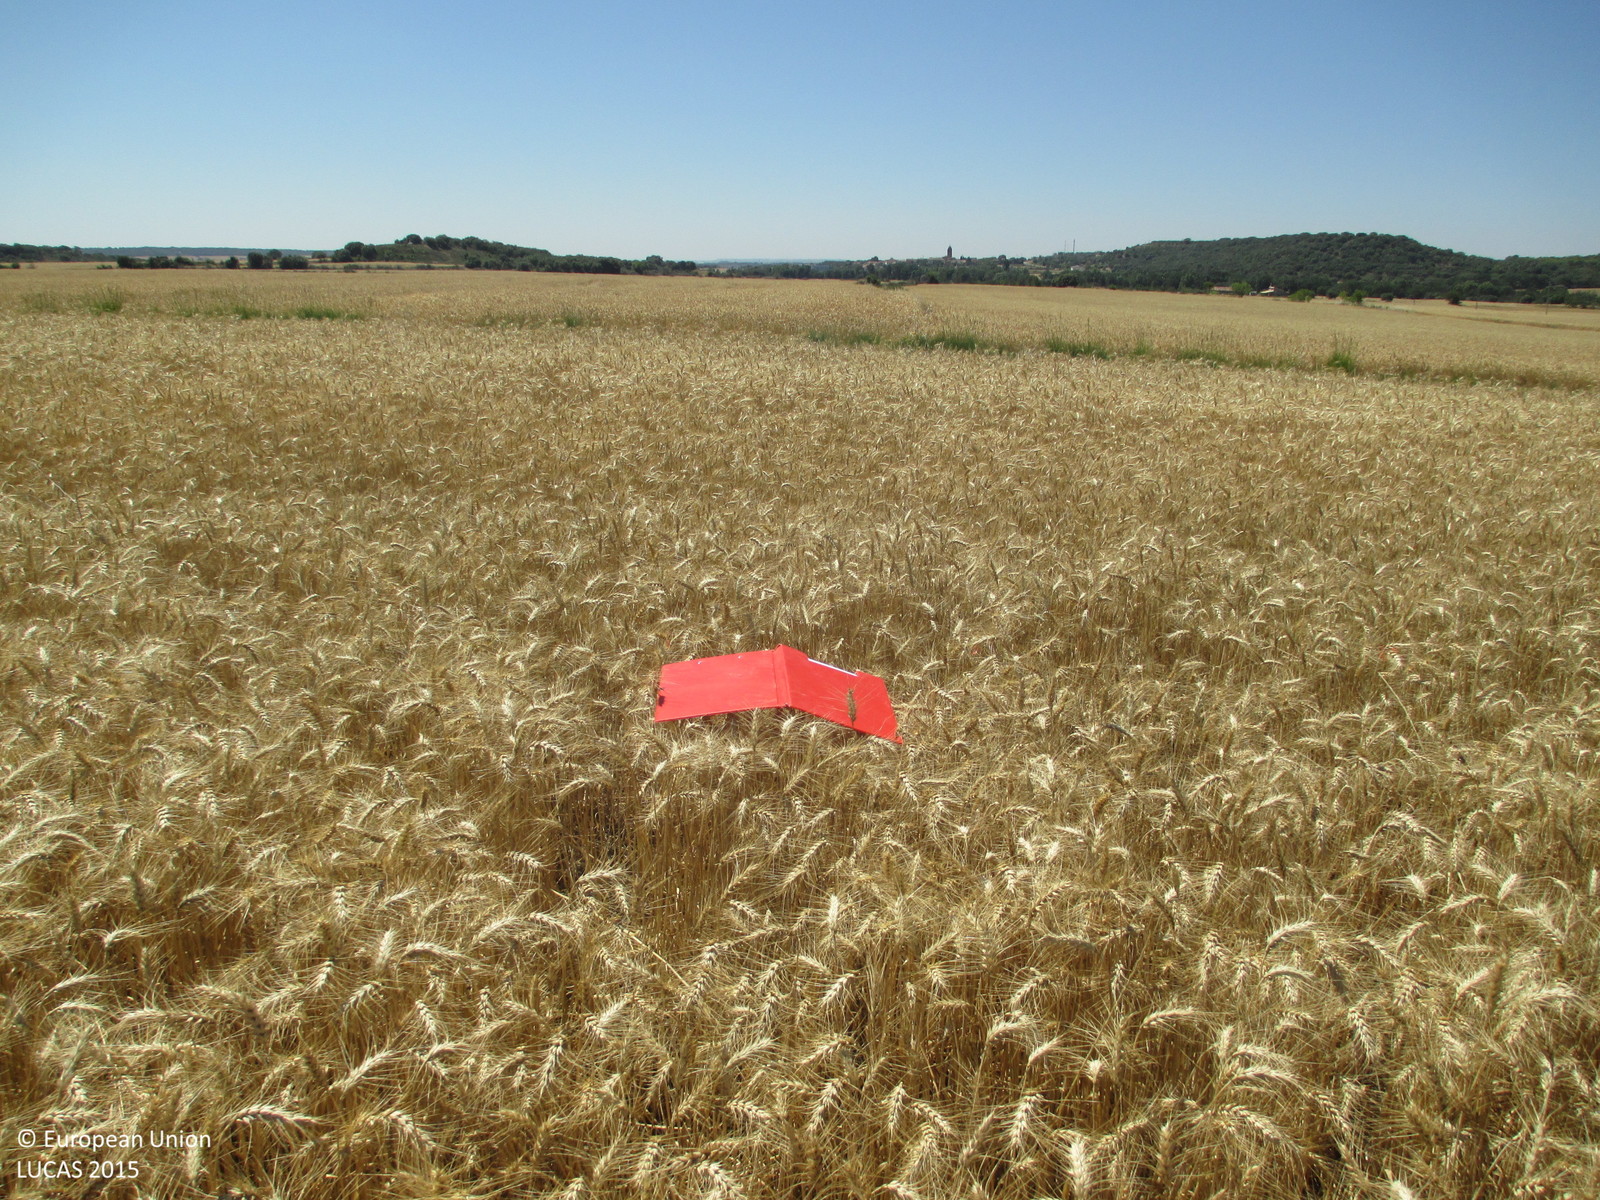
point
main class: Cropland
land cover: Durum wheat
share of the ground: > 75 %
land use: Agriculture (excluding fallow land and kitchen gardens)
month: June
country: ES
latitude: 42.1795
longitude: -0.3253
